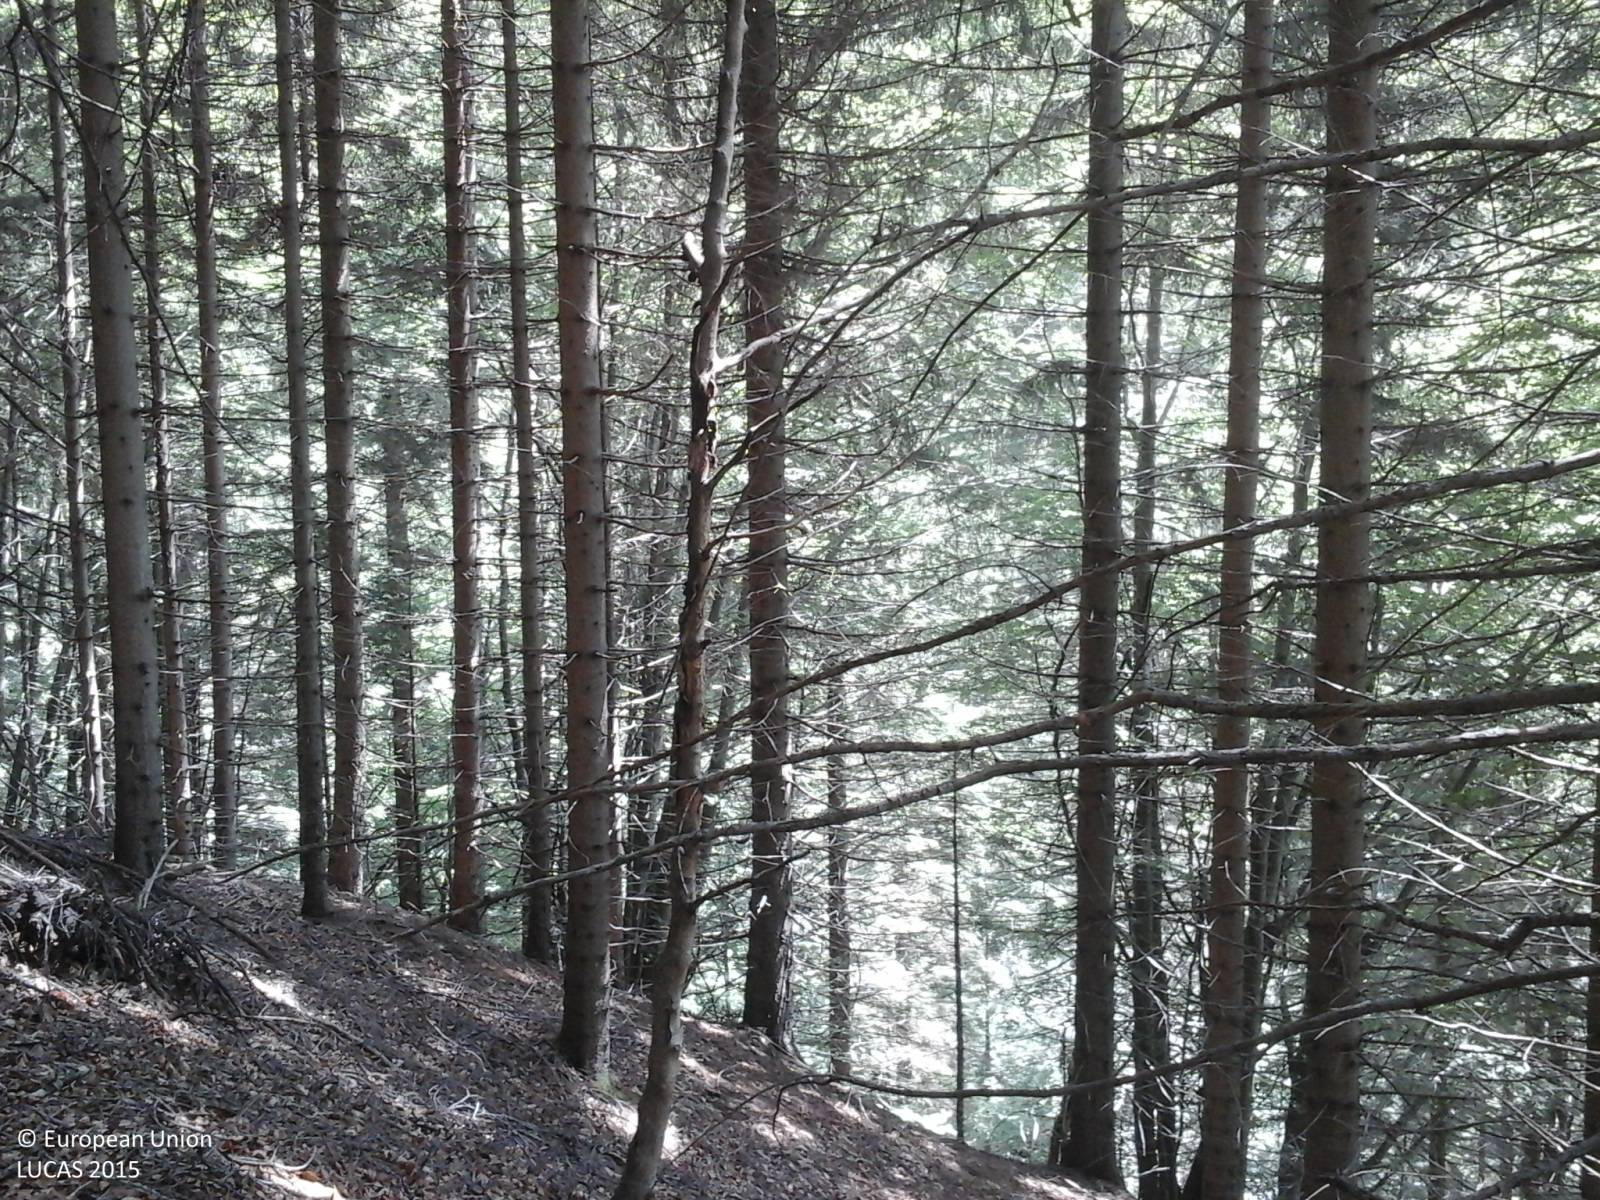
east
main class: Woodland
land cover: Other mixed woodland
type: alpine coniferous forest
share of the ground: > 75 %
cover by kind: coniferous forest trees 50 %, broadleaved forest trees 50 %
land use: Forestry
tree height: > 5 m
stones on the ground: < 10 %
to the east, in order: Other mixed woodland; Rivers and streams; Other mixed woodland; Paved roads, cycling and walking lanes; Other mixed woodland
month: July
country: IT
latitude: 46.5439
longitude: 12.9835
